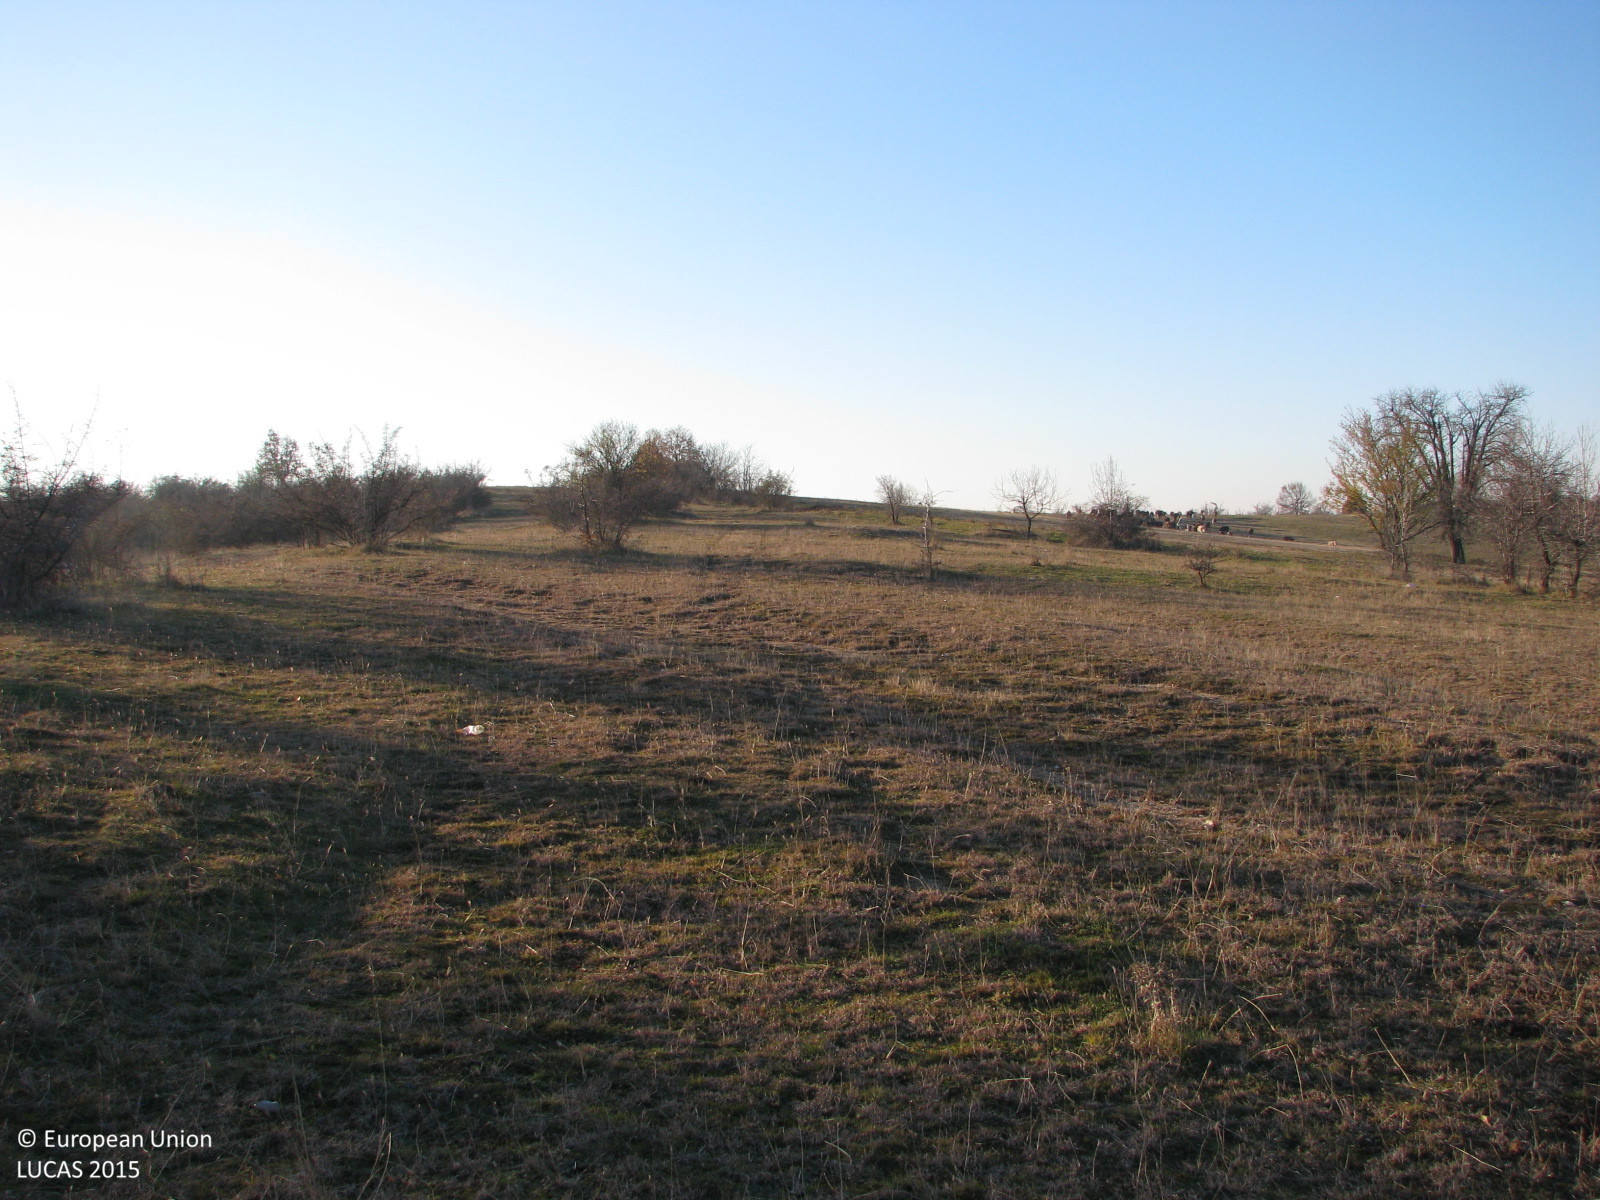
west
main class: Grassland
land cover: Grassland with sparse tree/shrub cover
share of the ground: > 75 %
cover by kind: herbaceous plants 70 %, lichens and mosses 20 %, broadleaved forest trees 5 %, shrubs 5 %
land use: Agriculture (excluding fallow land and kitchen gardens)
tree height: < 5 m
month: December
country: BG
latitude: 42.4001
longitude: 25.0646
